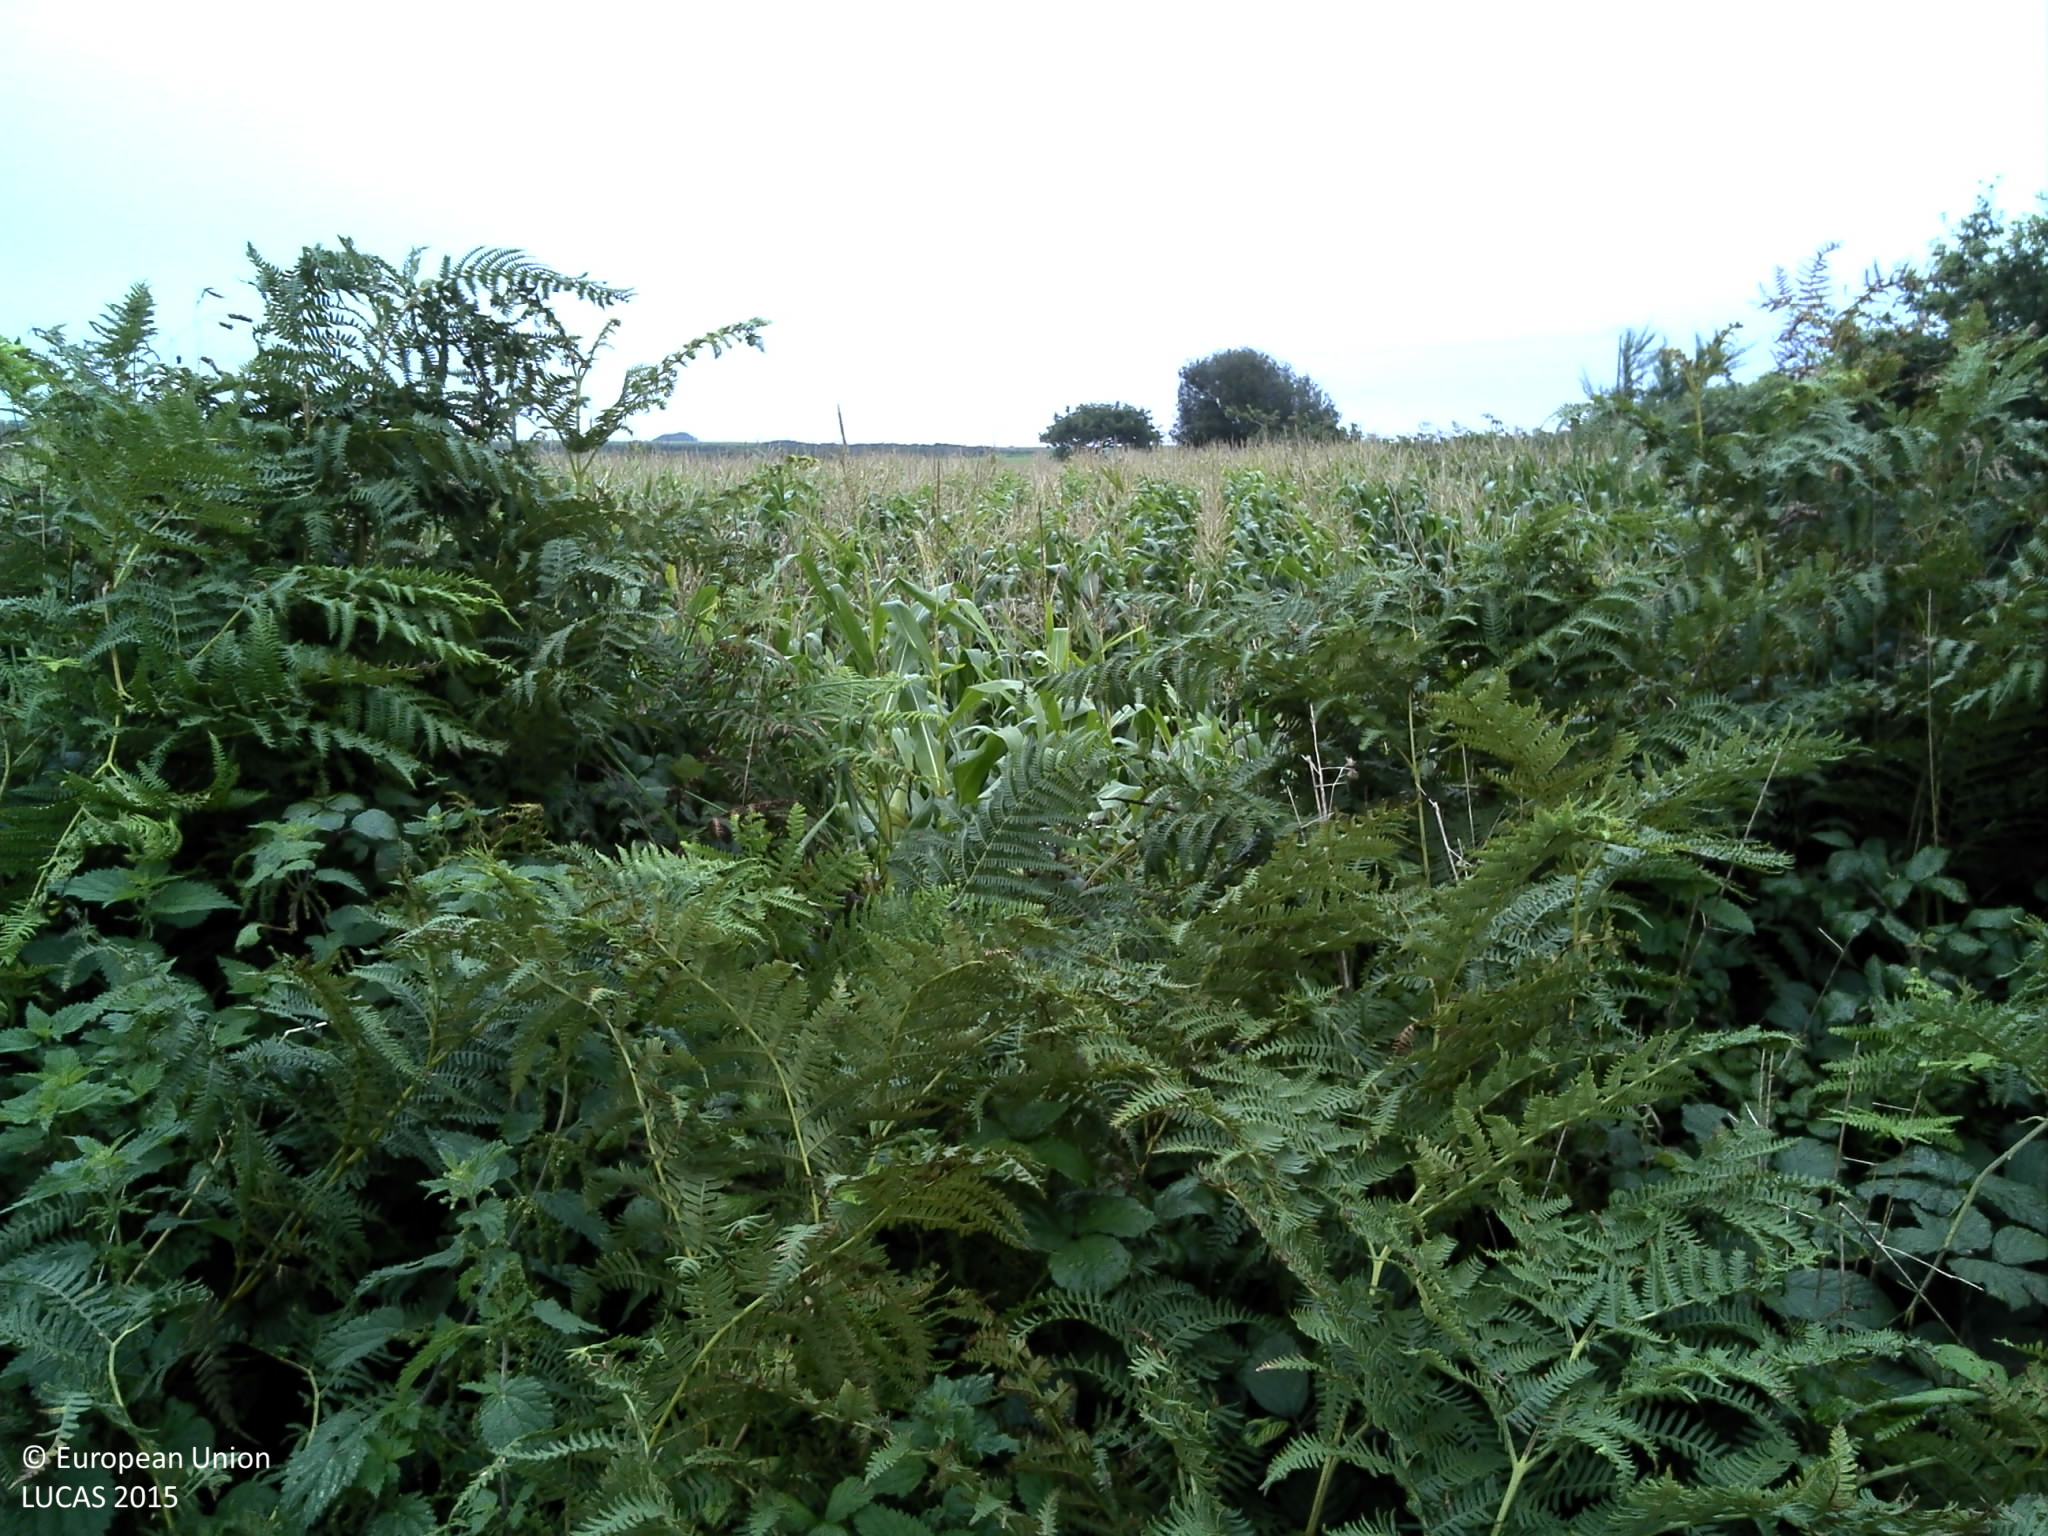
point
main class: Cropland
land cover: Maize
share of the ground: > 75 %
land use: Agriculture (excluding fallow land and kitchen gardens)
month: August
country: FR
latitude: 48.6085
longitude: -4.2399
